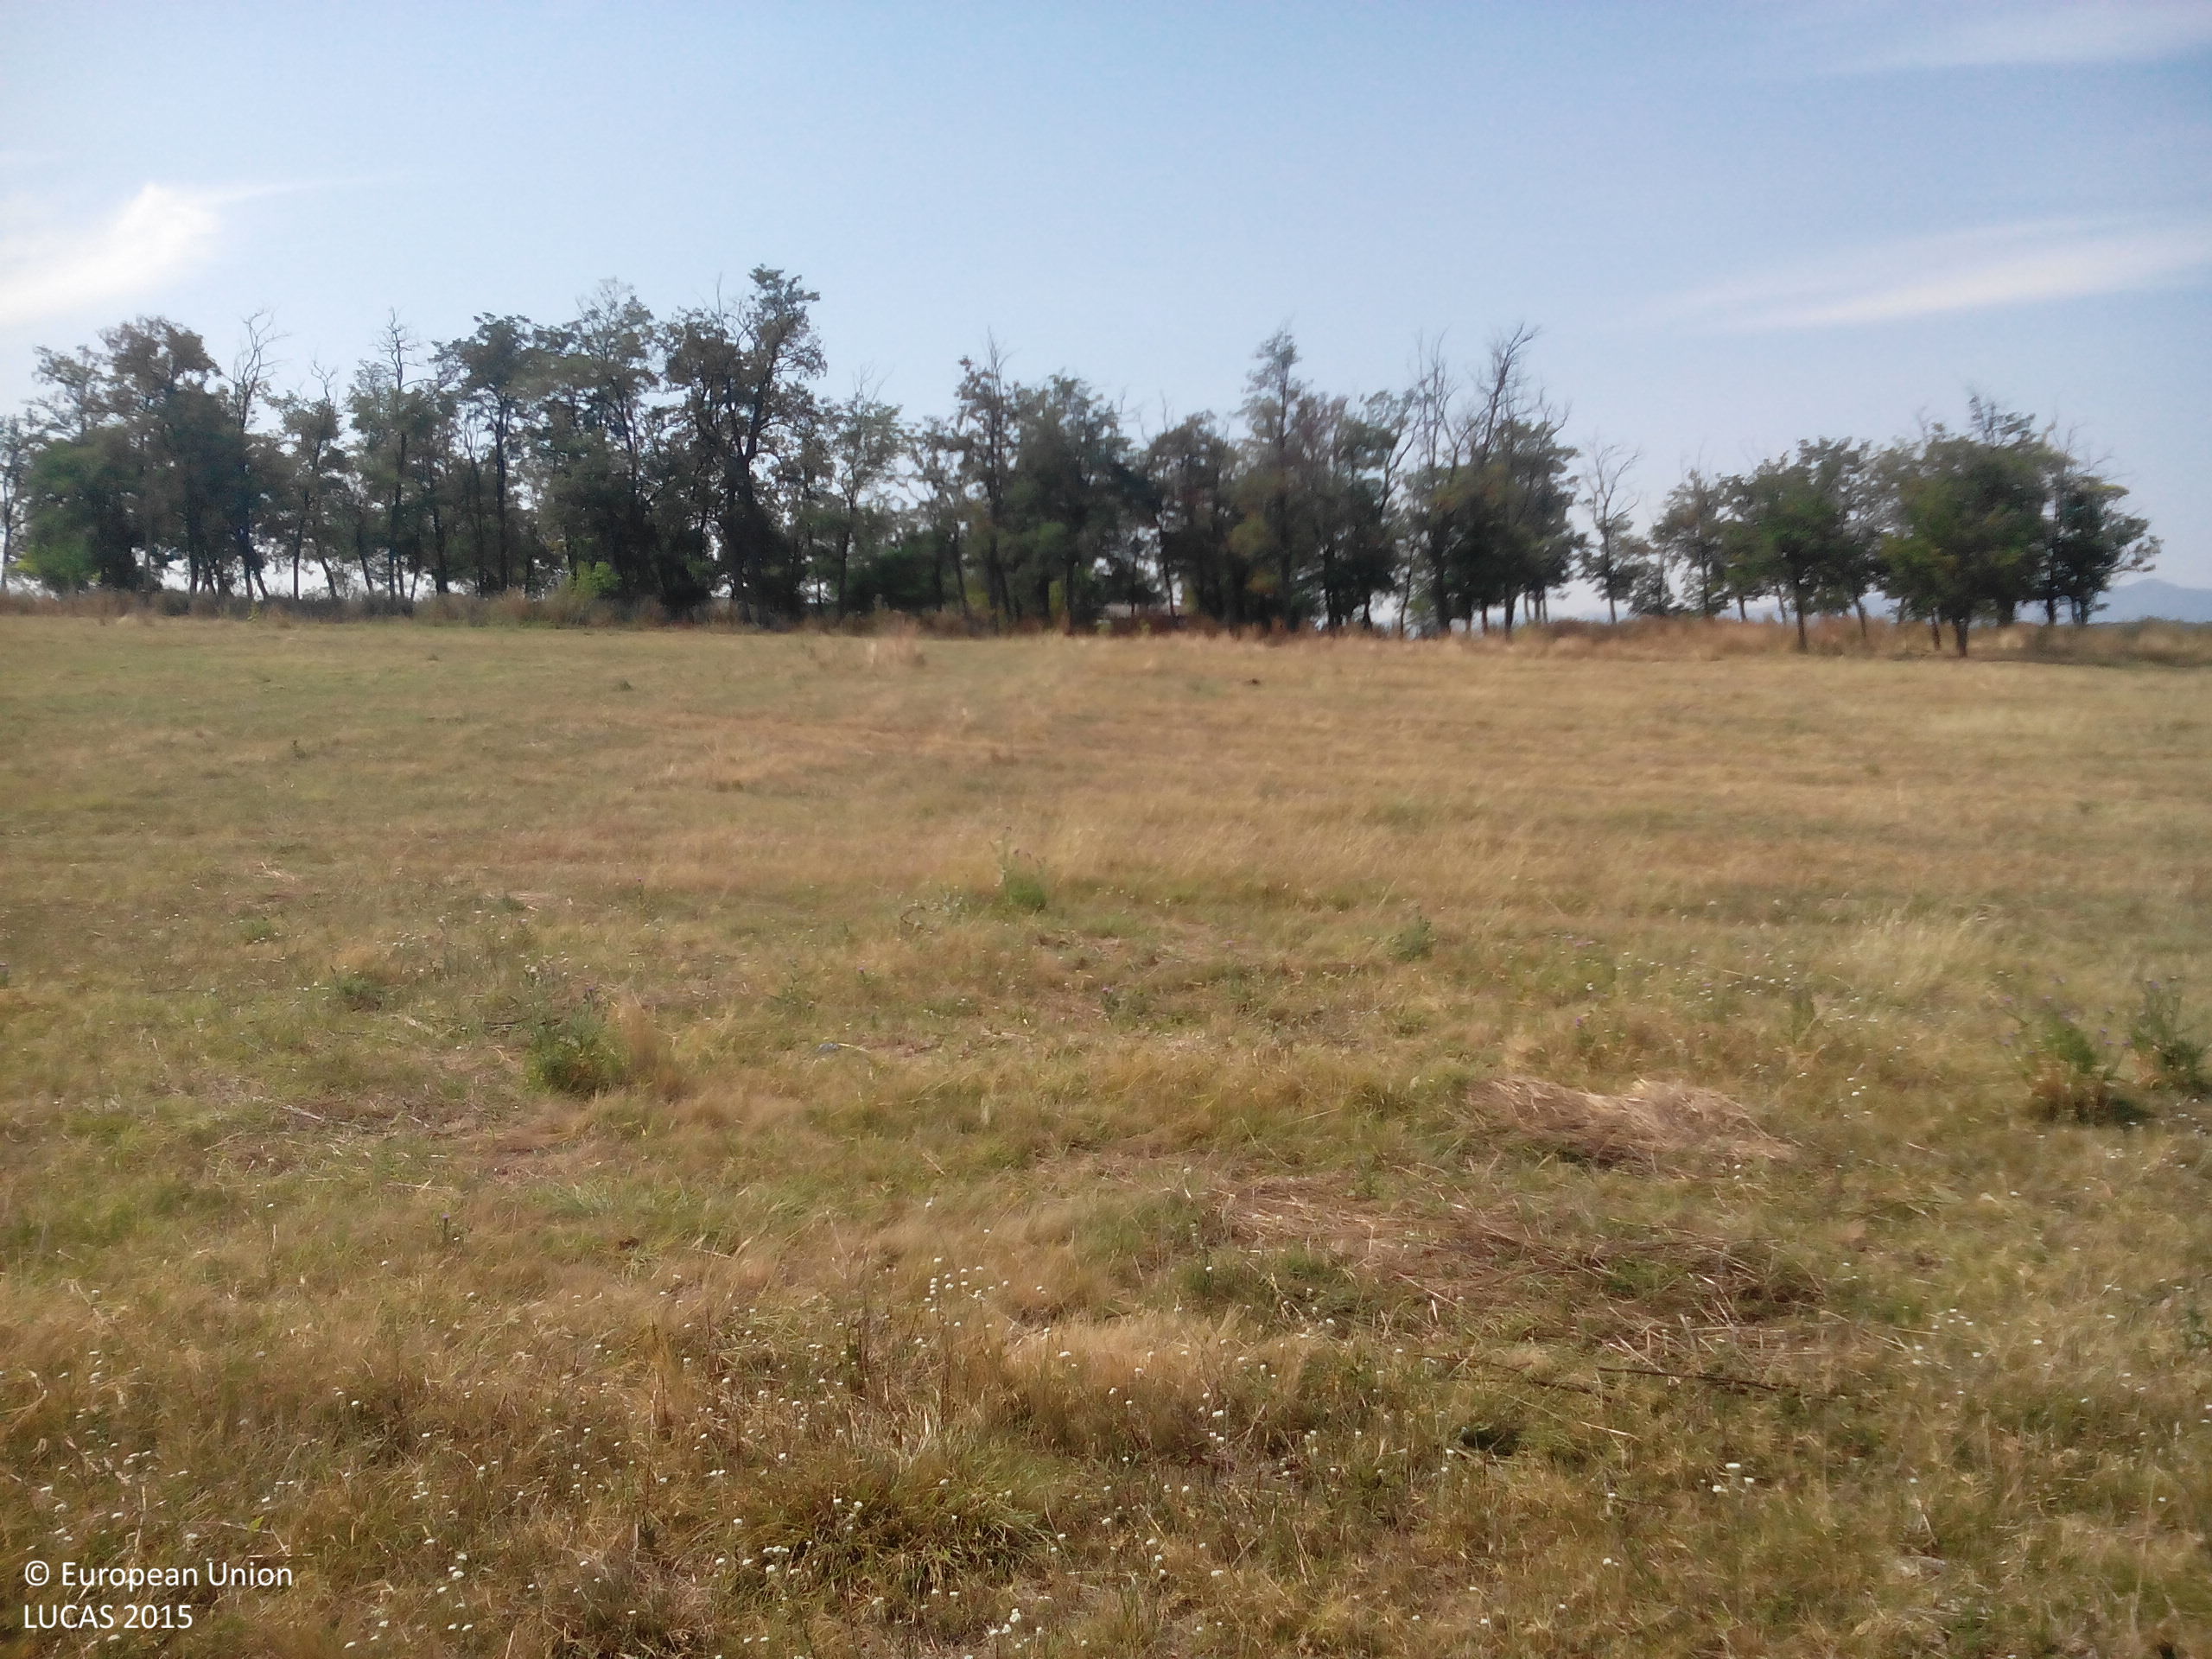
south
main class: Grassland
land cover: Grassland without tree/shrub cover
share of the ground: > 75 %
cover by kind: herbaceous plants 100 %
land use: Agriculture (excluding fallow land and kitchen gardens)
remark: Harvested field
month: August
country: BG
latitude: 43.3826
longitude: 23.5607
